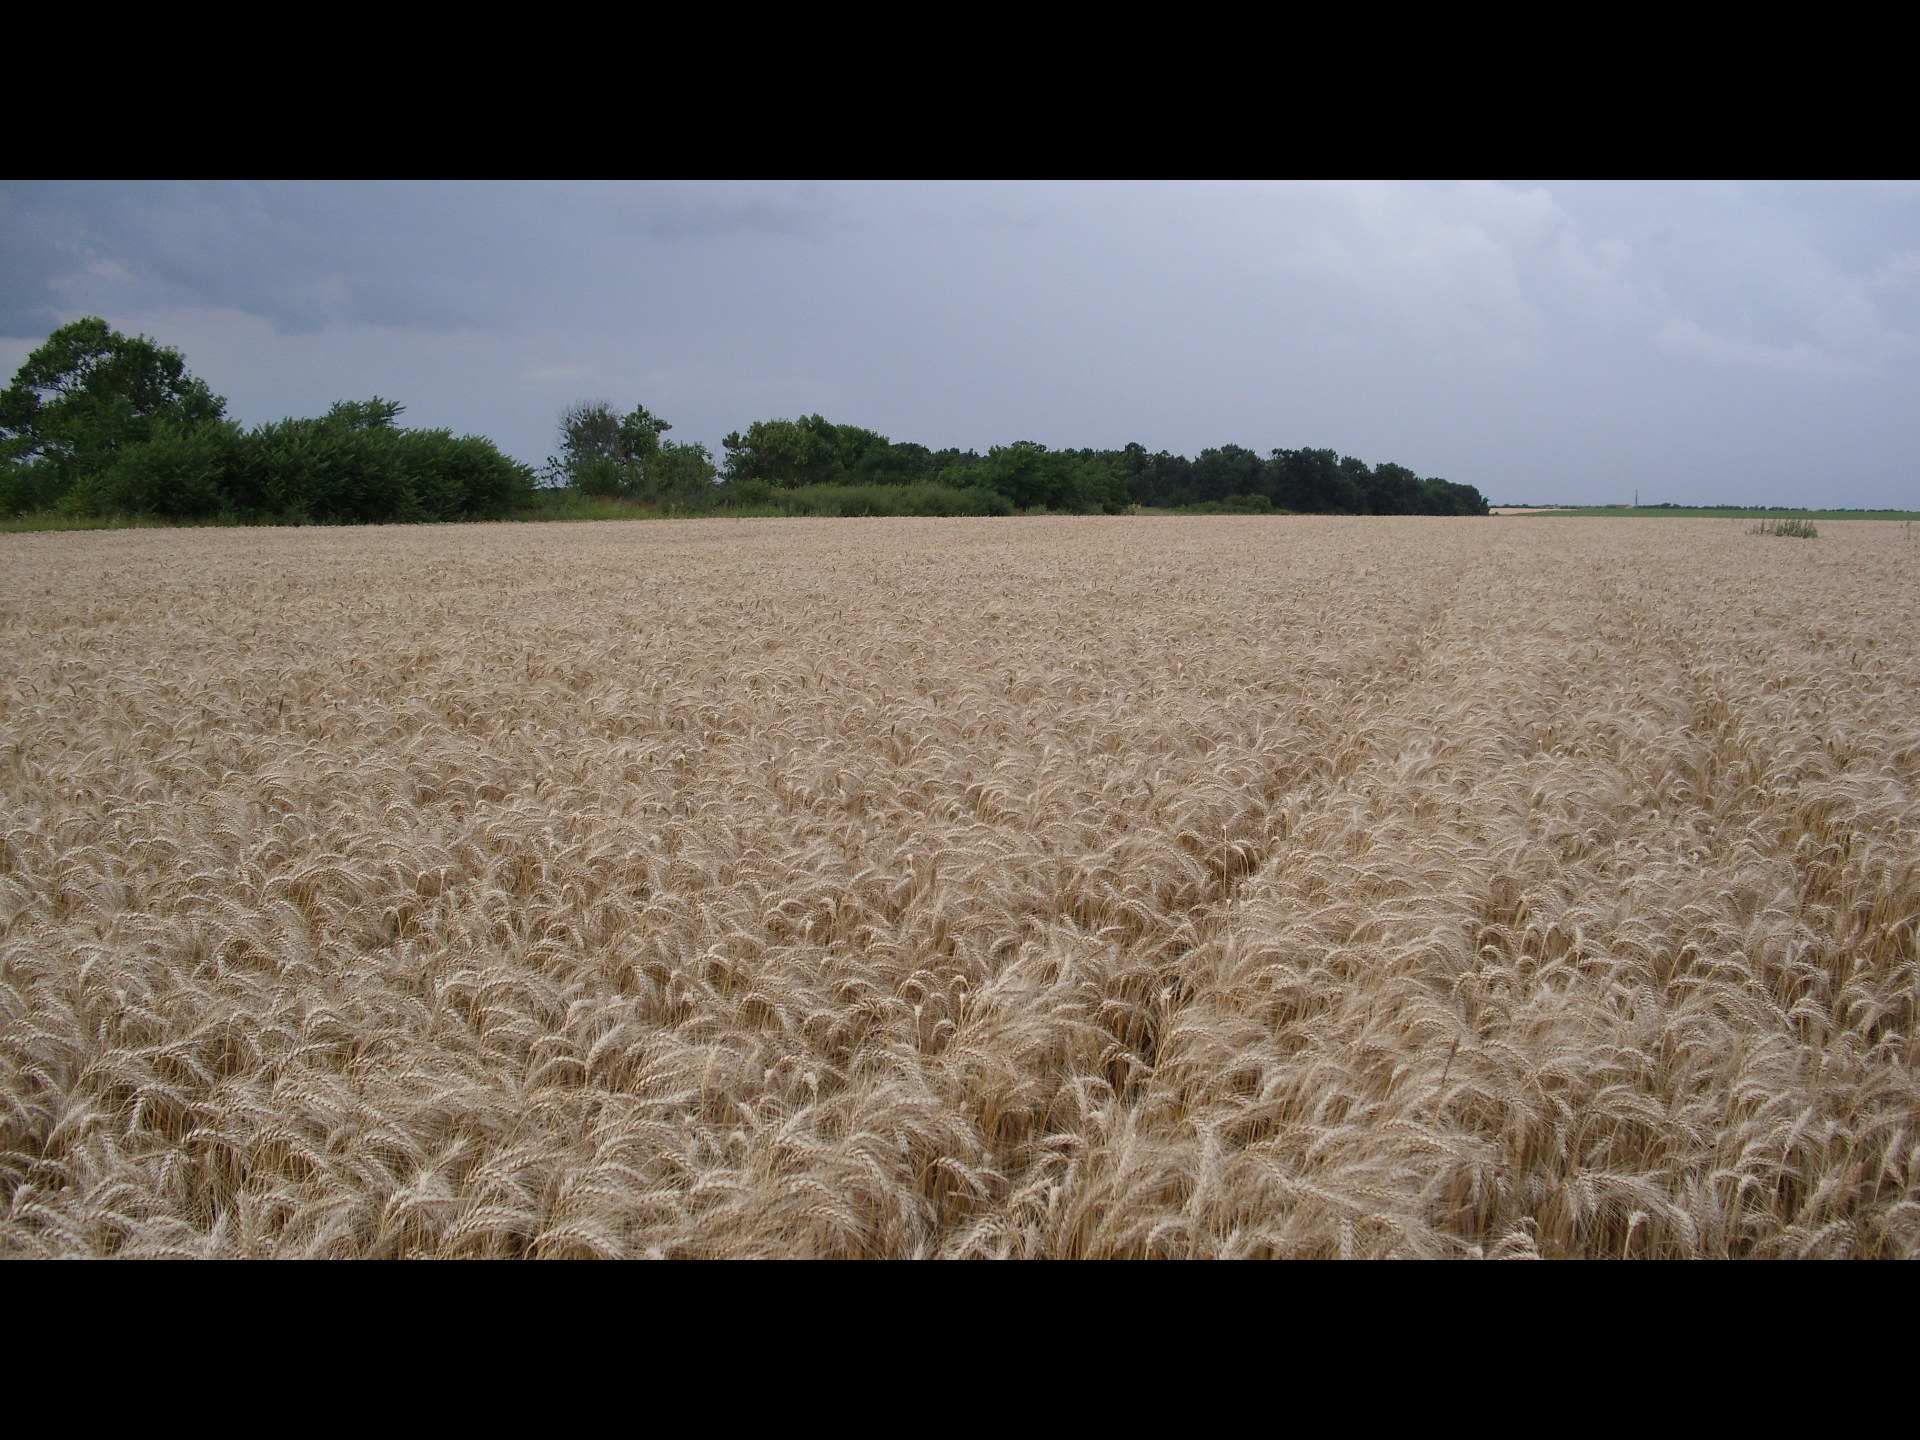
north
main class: Cropland
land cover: Common wheat
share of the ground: 10 - 25 %
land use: Agriculture (excluding fallow land and kitchen gardens)
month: June
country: BG
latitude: 43.5647
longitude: 23.4276
